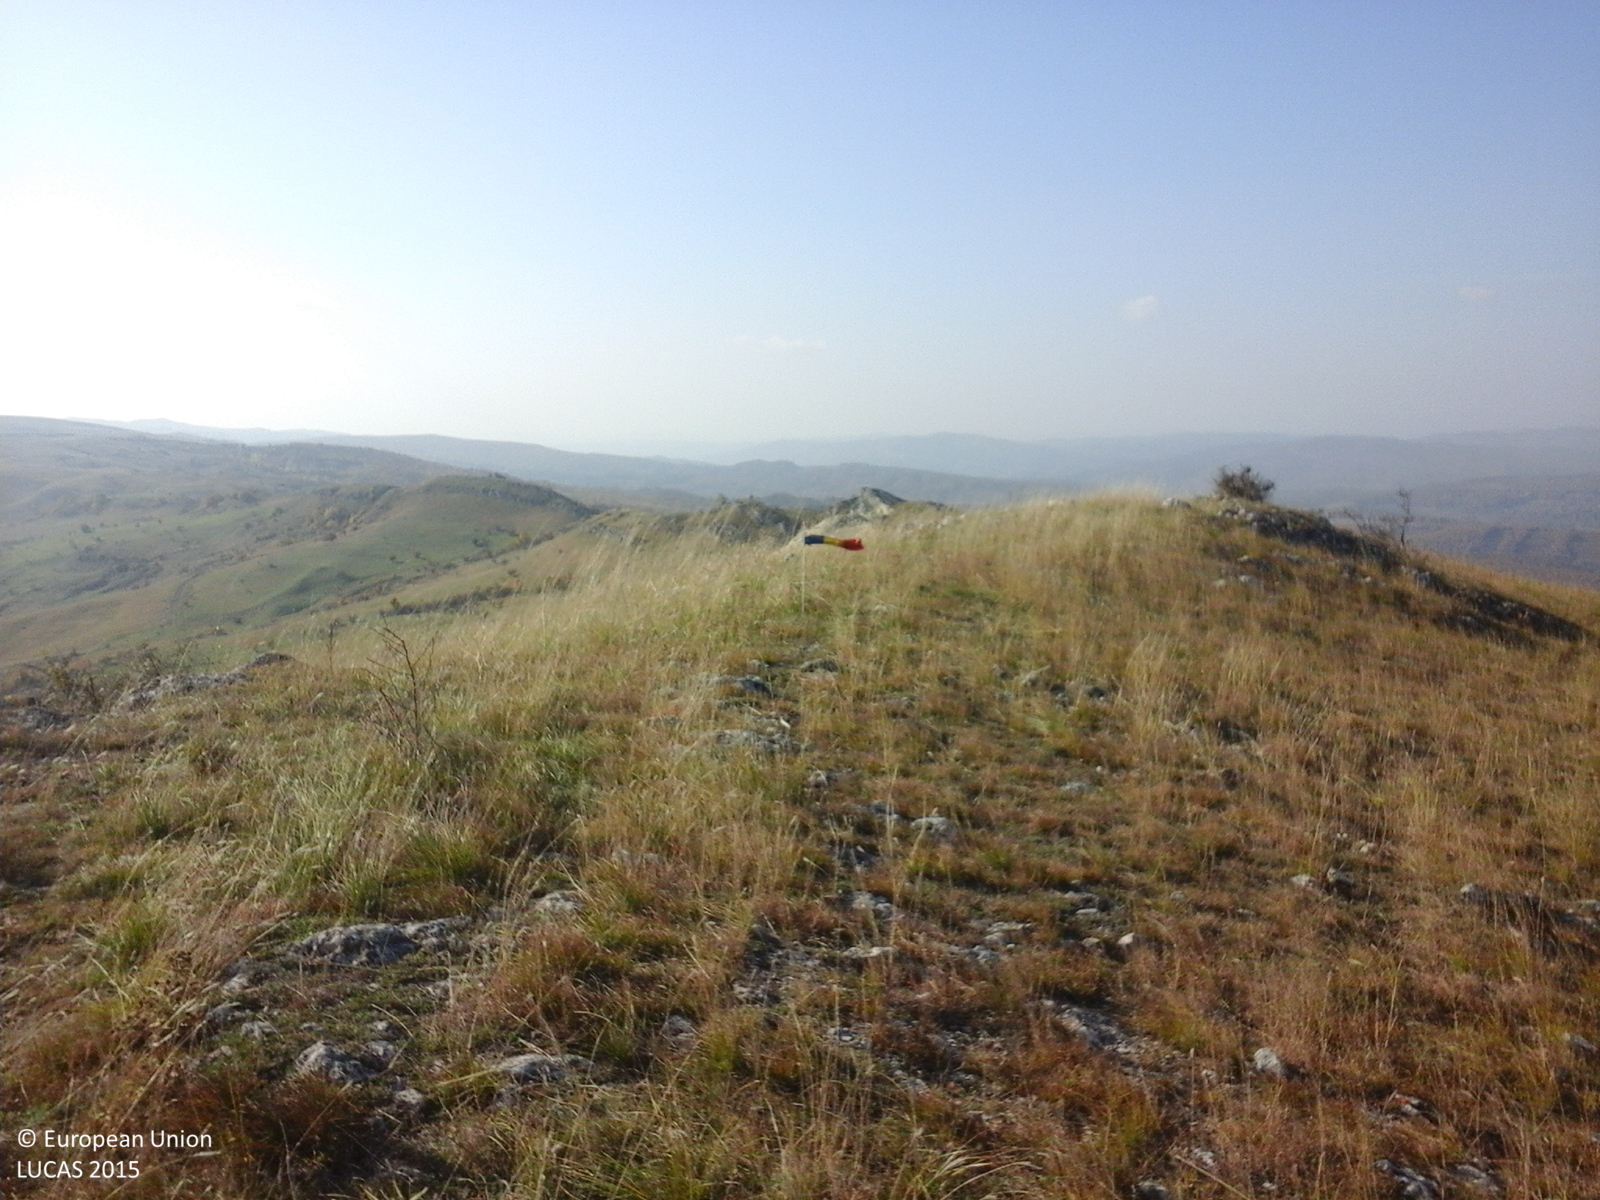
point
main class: Grassland
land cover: Grassland without tree/shrub cover
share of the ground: > 75 %
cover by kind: herbaceous plants 100 %
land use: Agriculture (excluding fallow land and kitchen gardens)
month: October
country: RO
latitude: 45.1165
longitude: 26.4813
